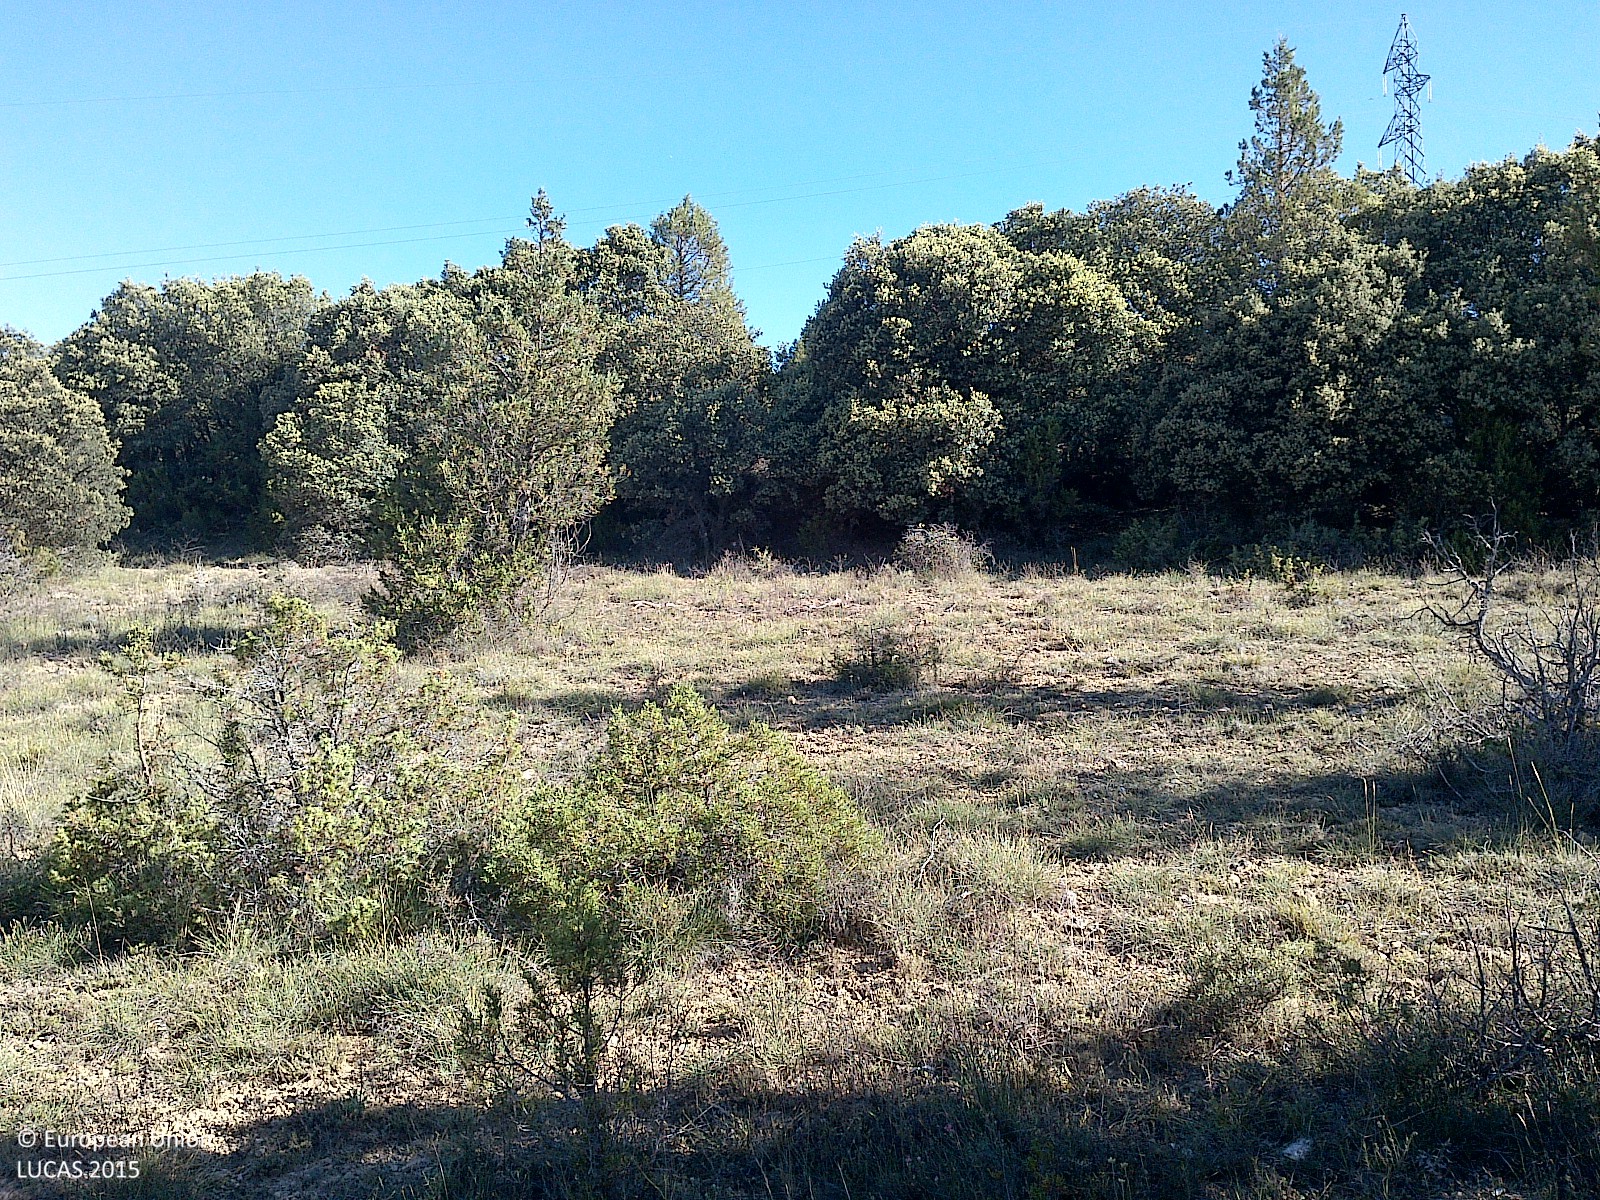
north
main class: Woodland
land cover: Other coniferous woodland
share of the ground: 10 - 25 %
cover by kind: herbaceous plants 65 %, coniferous forest trees 15 %, shrubs 15 %, unconsolidated bare surface 5 %
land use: Semi-natural and natural areas not in use
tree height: < 5 m
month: July
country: ES
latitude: 41.6935
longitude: -2.7893
